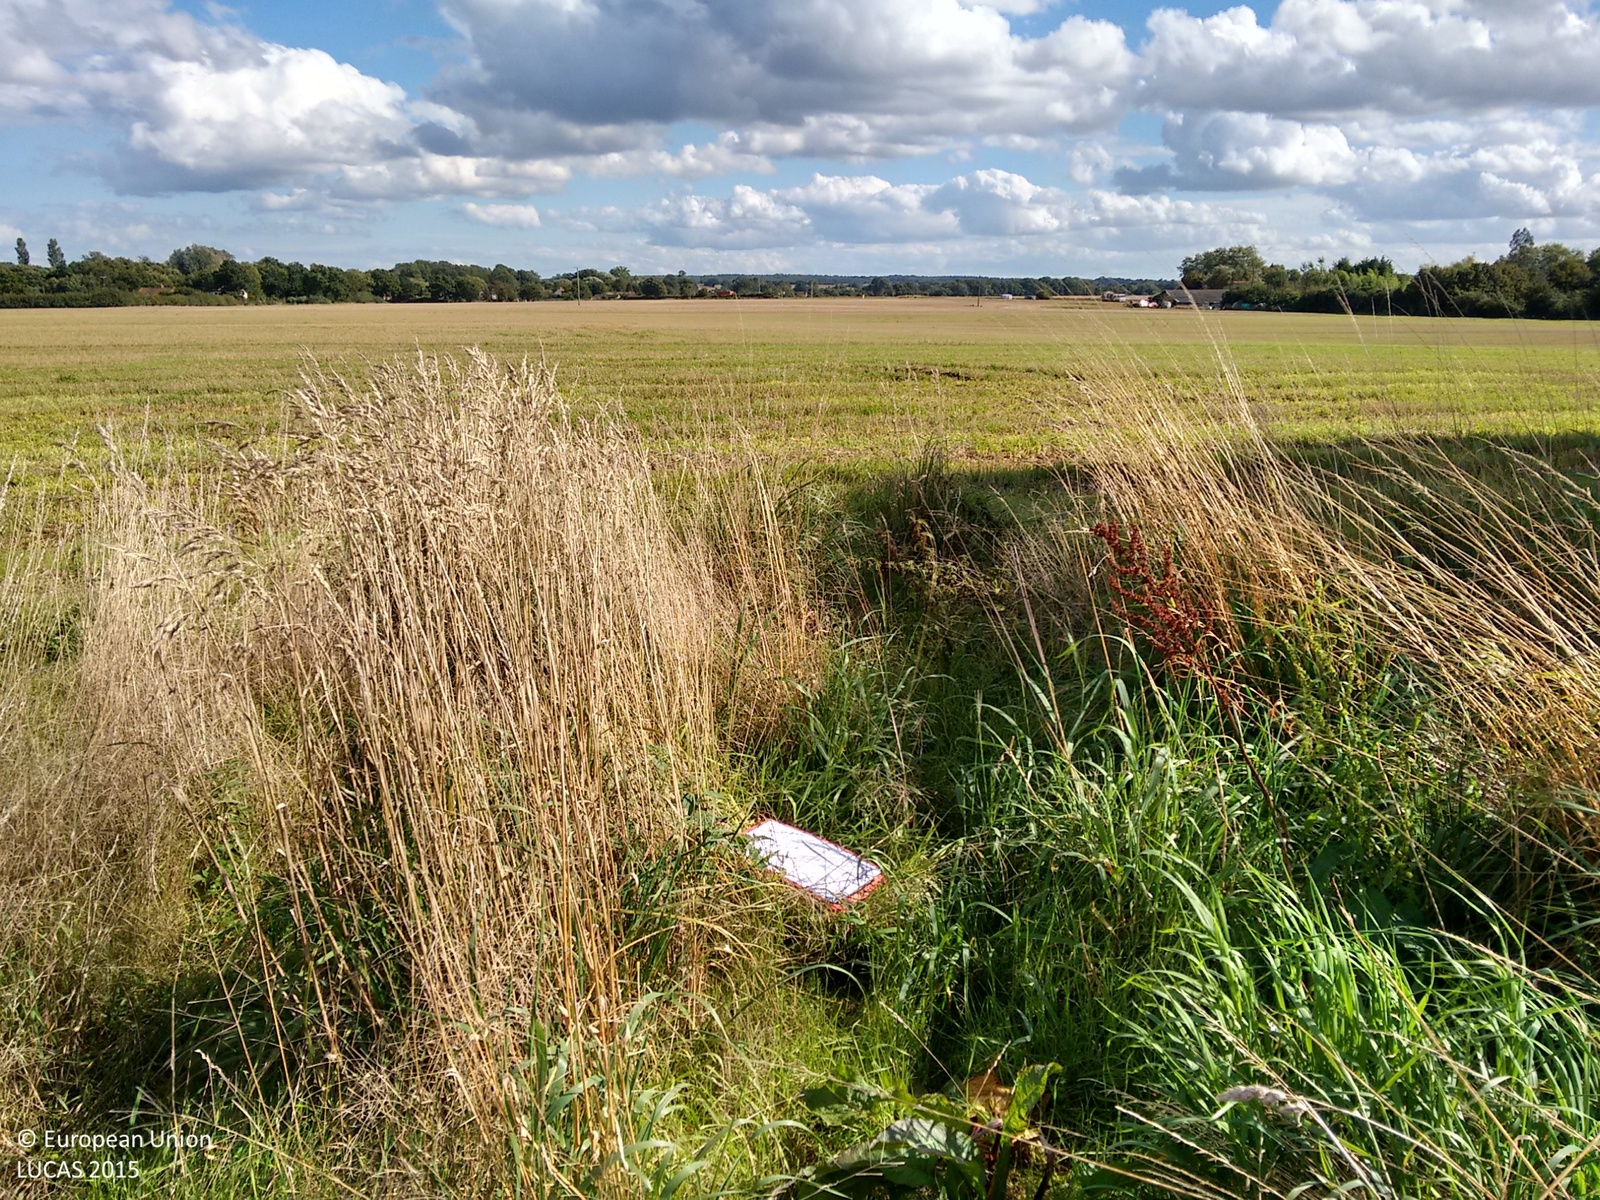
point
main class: Grassland
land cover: Grassland without tree/shrub cover
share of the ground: > 75 %
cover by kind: herbaceous plants 100 %
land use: Agriculture (excluding fallow land and kitchen gardens)
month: September
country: GB
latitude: 52.8171
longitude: 1.2994
